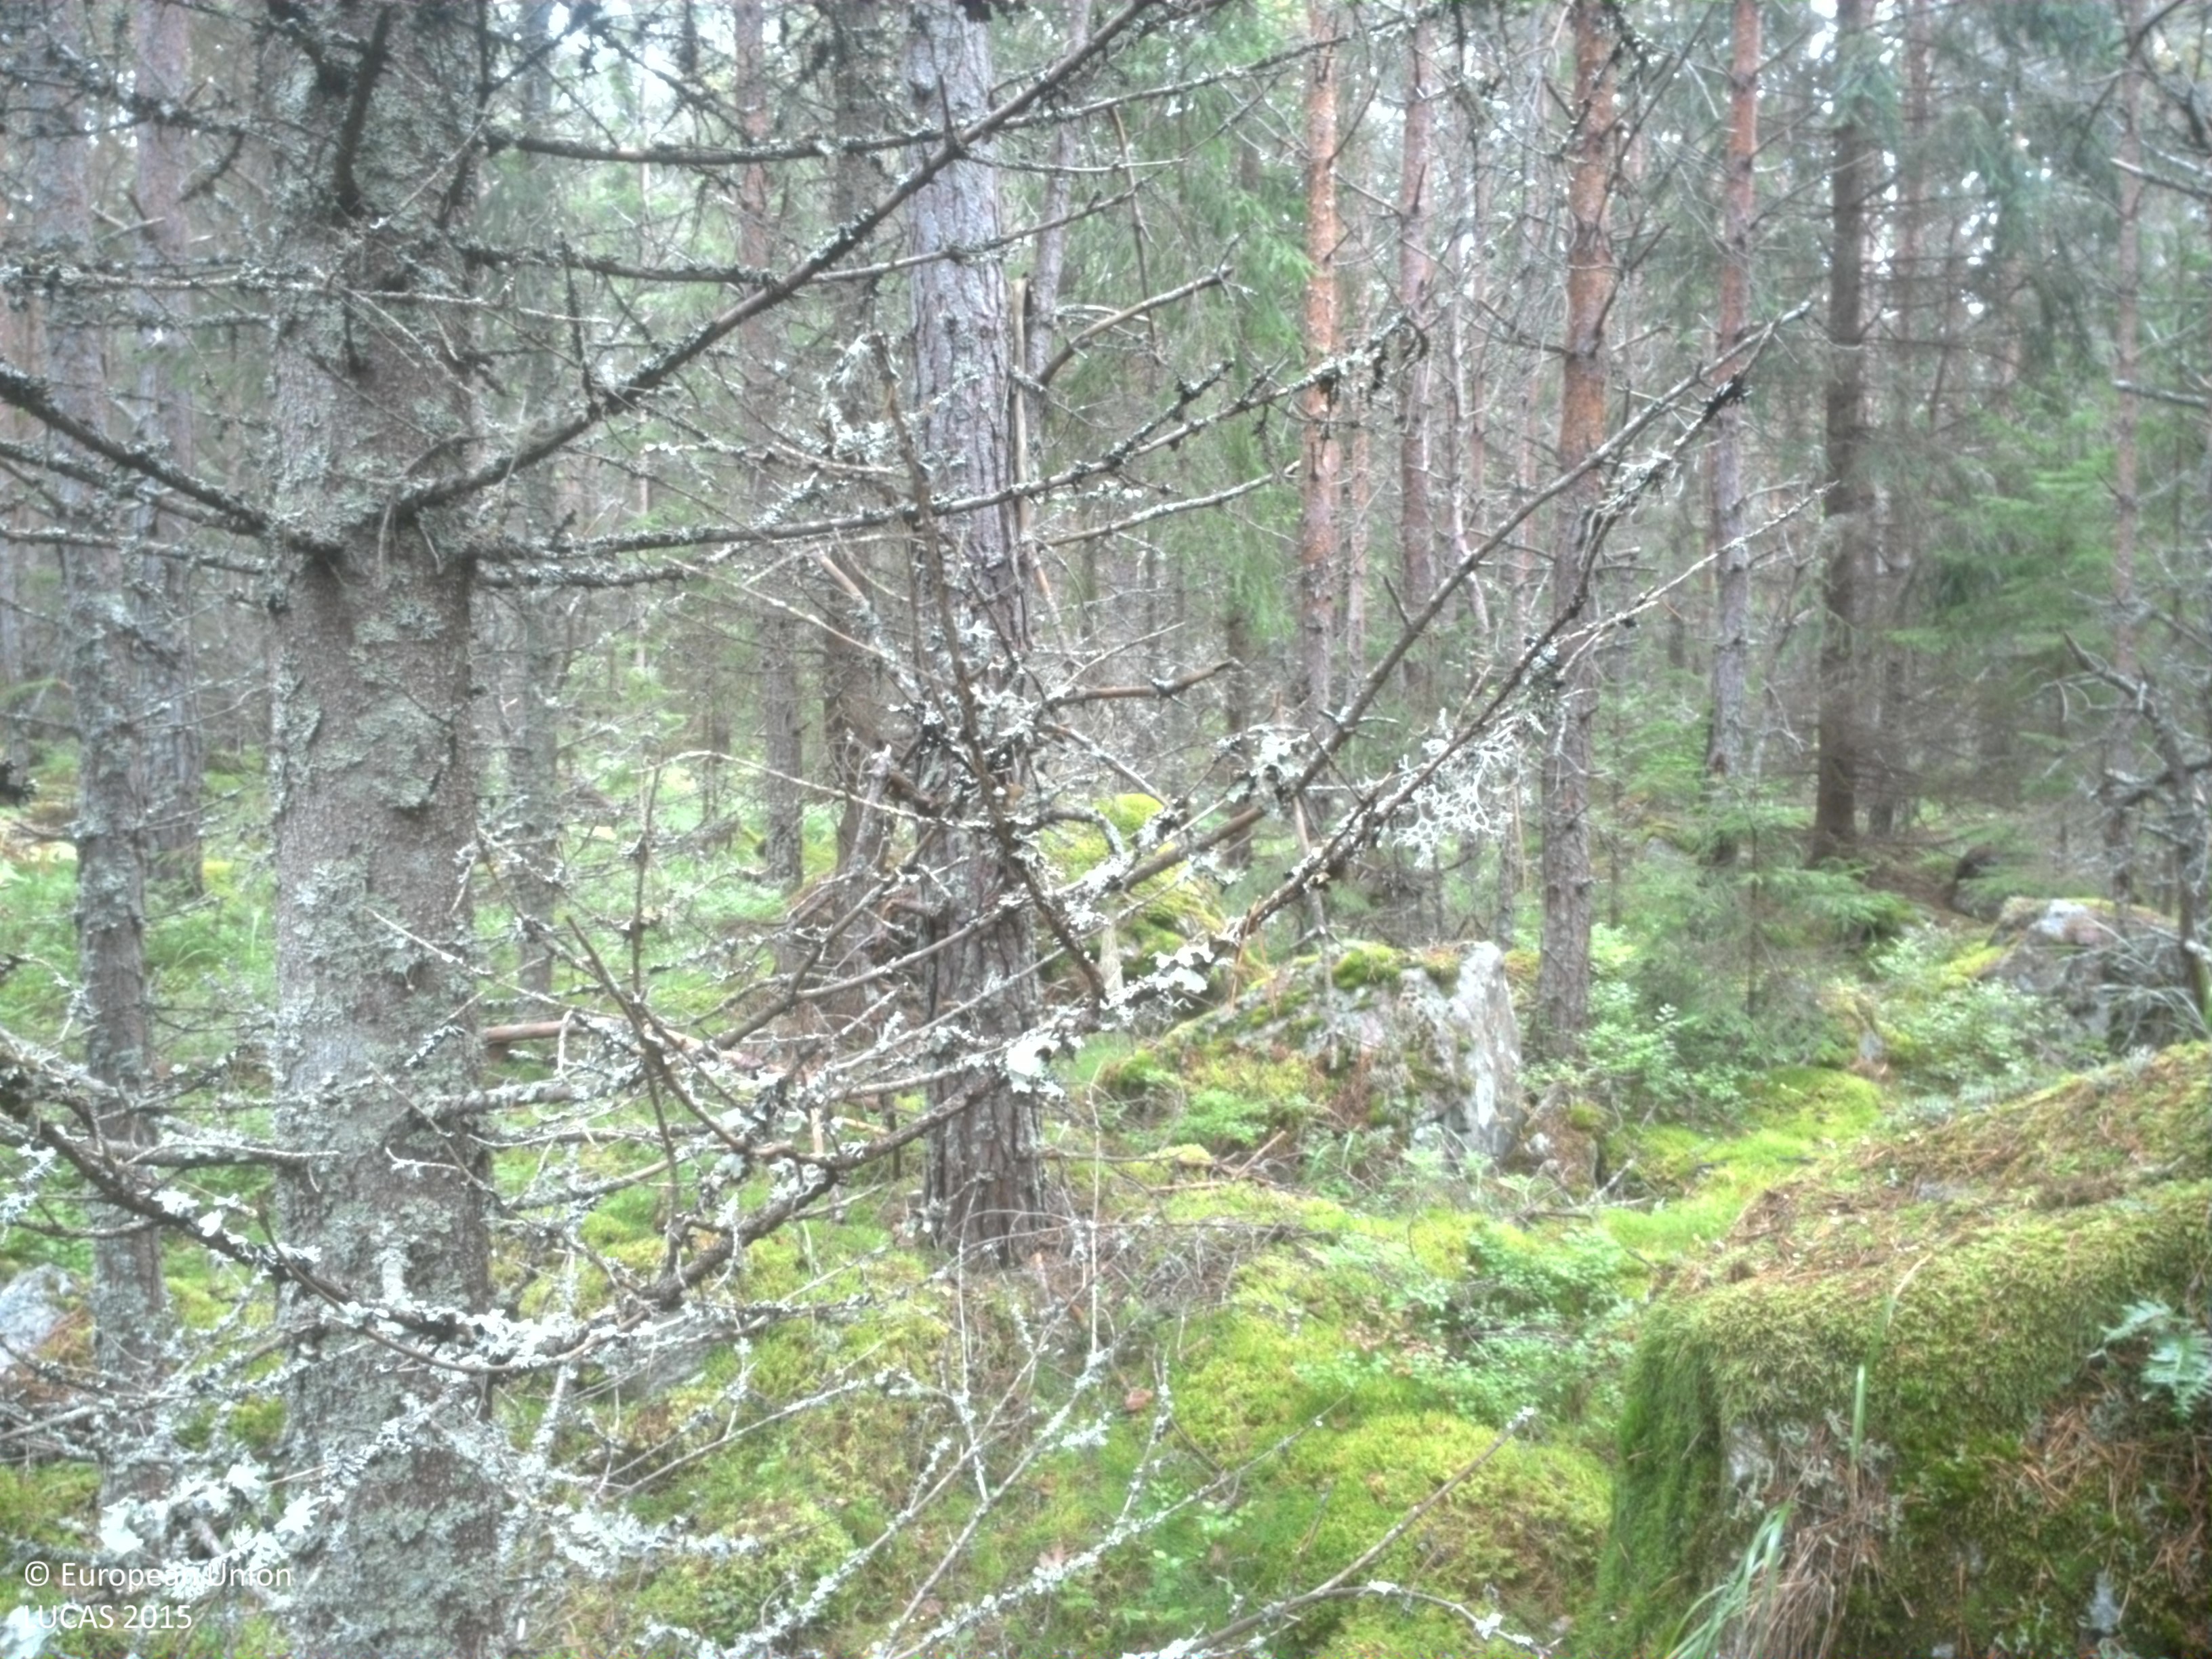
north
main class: Woodland
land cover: Other coniferous woodland
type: boreal forest
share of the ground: > 75 %
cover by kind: coniferous forest trees 75 %, lichens and mosses 15 %, shrubs 10 %
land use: Forestry
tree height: > 5 m
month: September
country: SE
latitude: 59.6523
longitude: 15.6512
